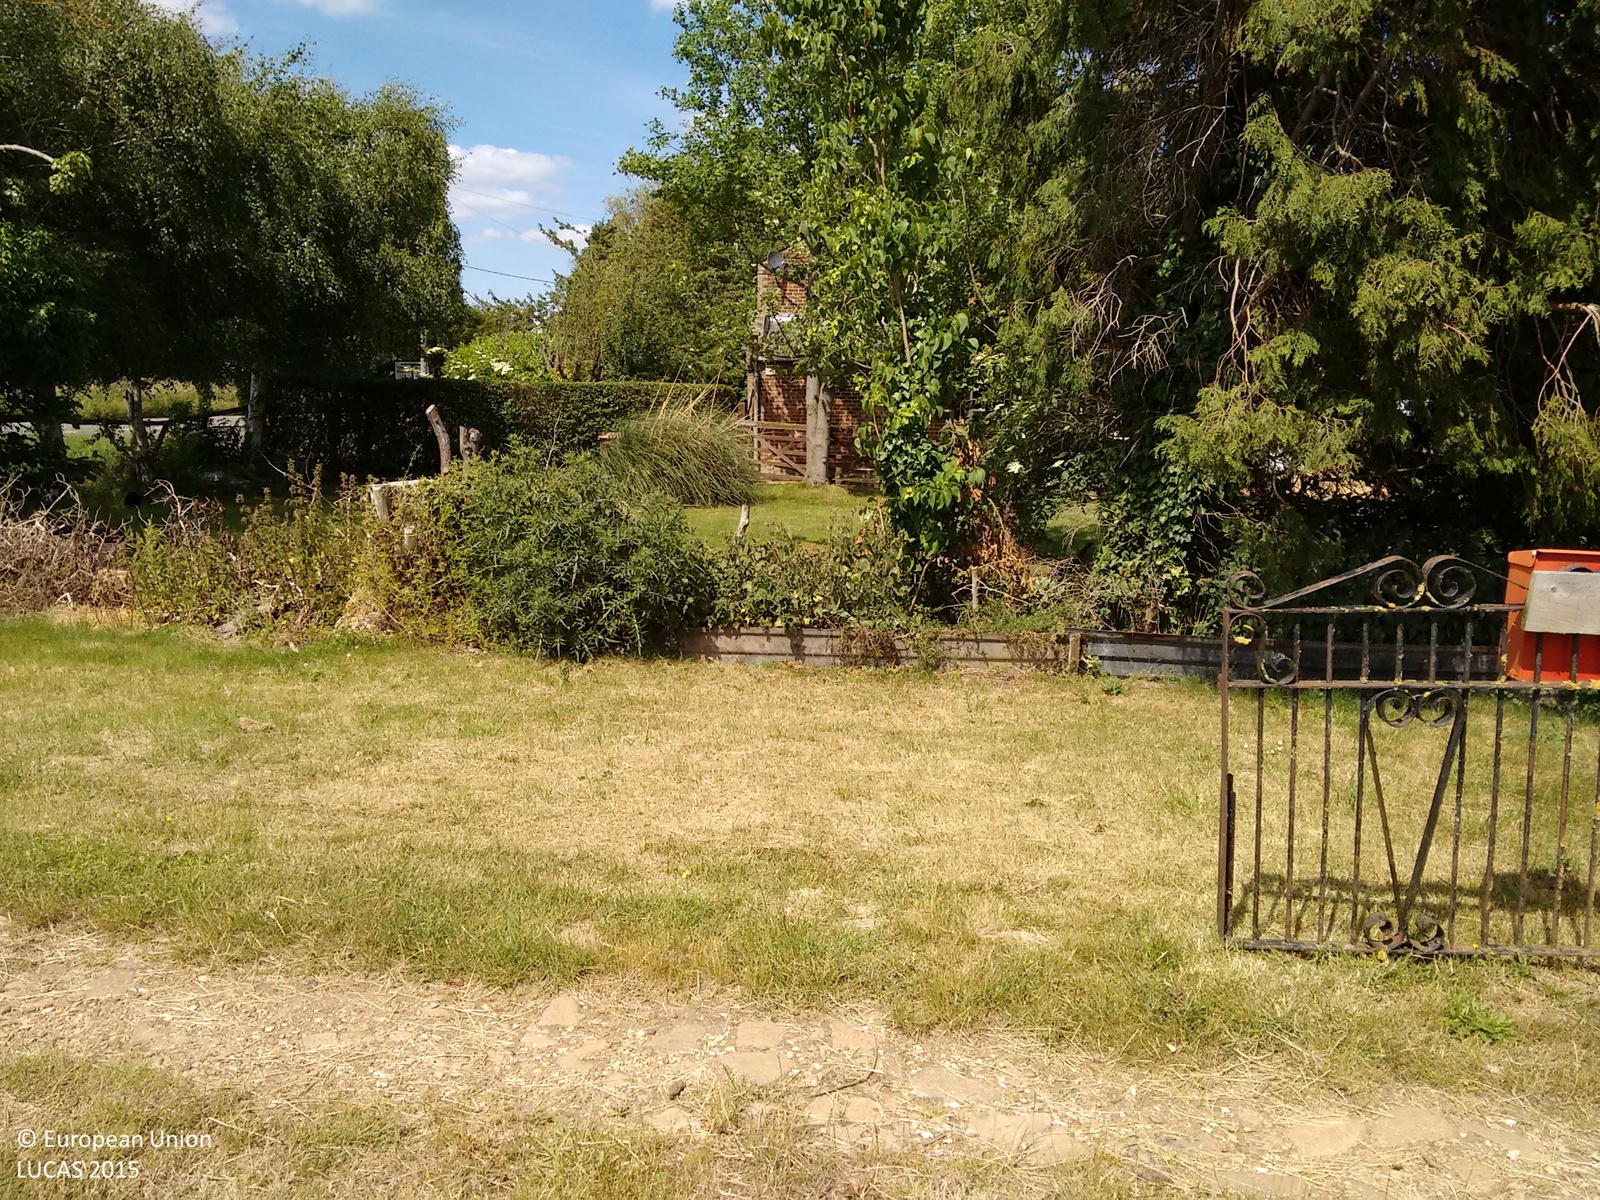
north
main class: Grassland
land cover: Grassland without tree/shrub cover
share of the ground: > 75 %
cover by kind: herbaceous plants 100 %
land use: Residential
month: June
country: GB
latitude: 52.5783
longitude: 0.0960
